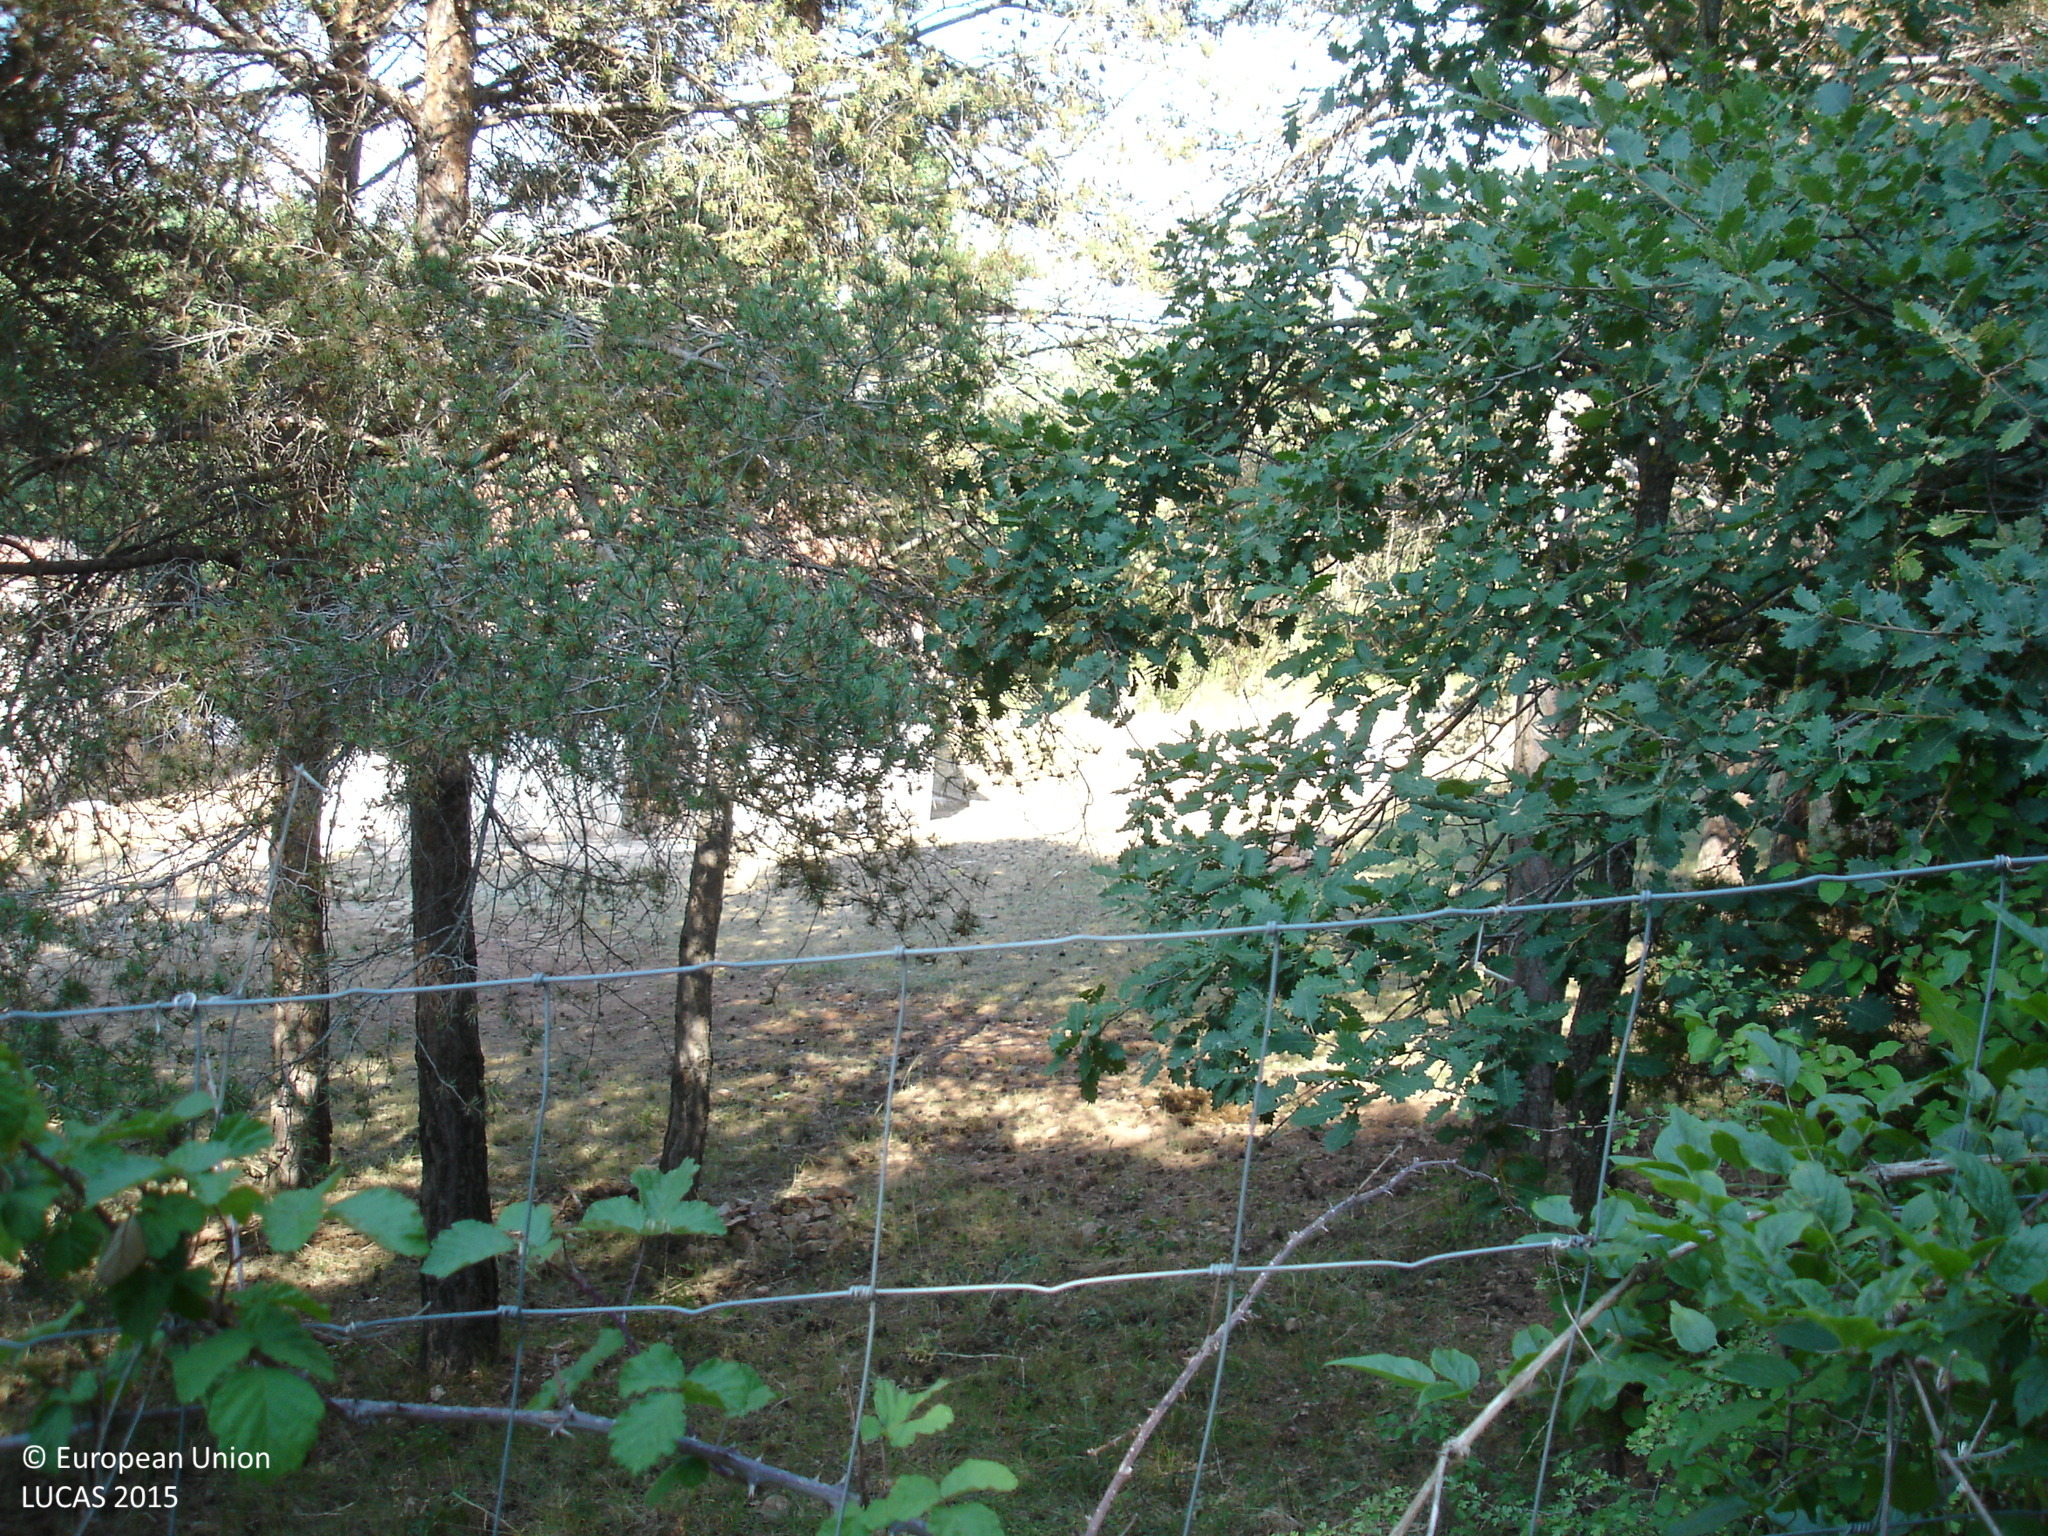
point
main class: Woodland
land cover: Other mixed woodland
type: thermophilous deciduous forest
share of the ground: 25 - 50 %
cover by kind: herbaceous plants 50 %, broadleaved forest trees 30 %, coniferous forest trees 10 %, shrubs 5 %
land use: Forestry
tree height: > 5 m
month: July
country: ES
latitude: 41.8610
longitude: 2.1728
